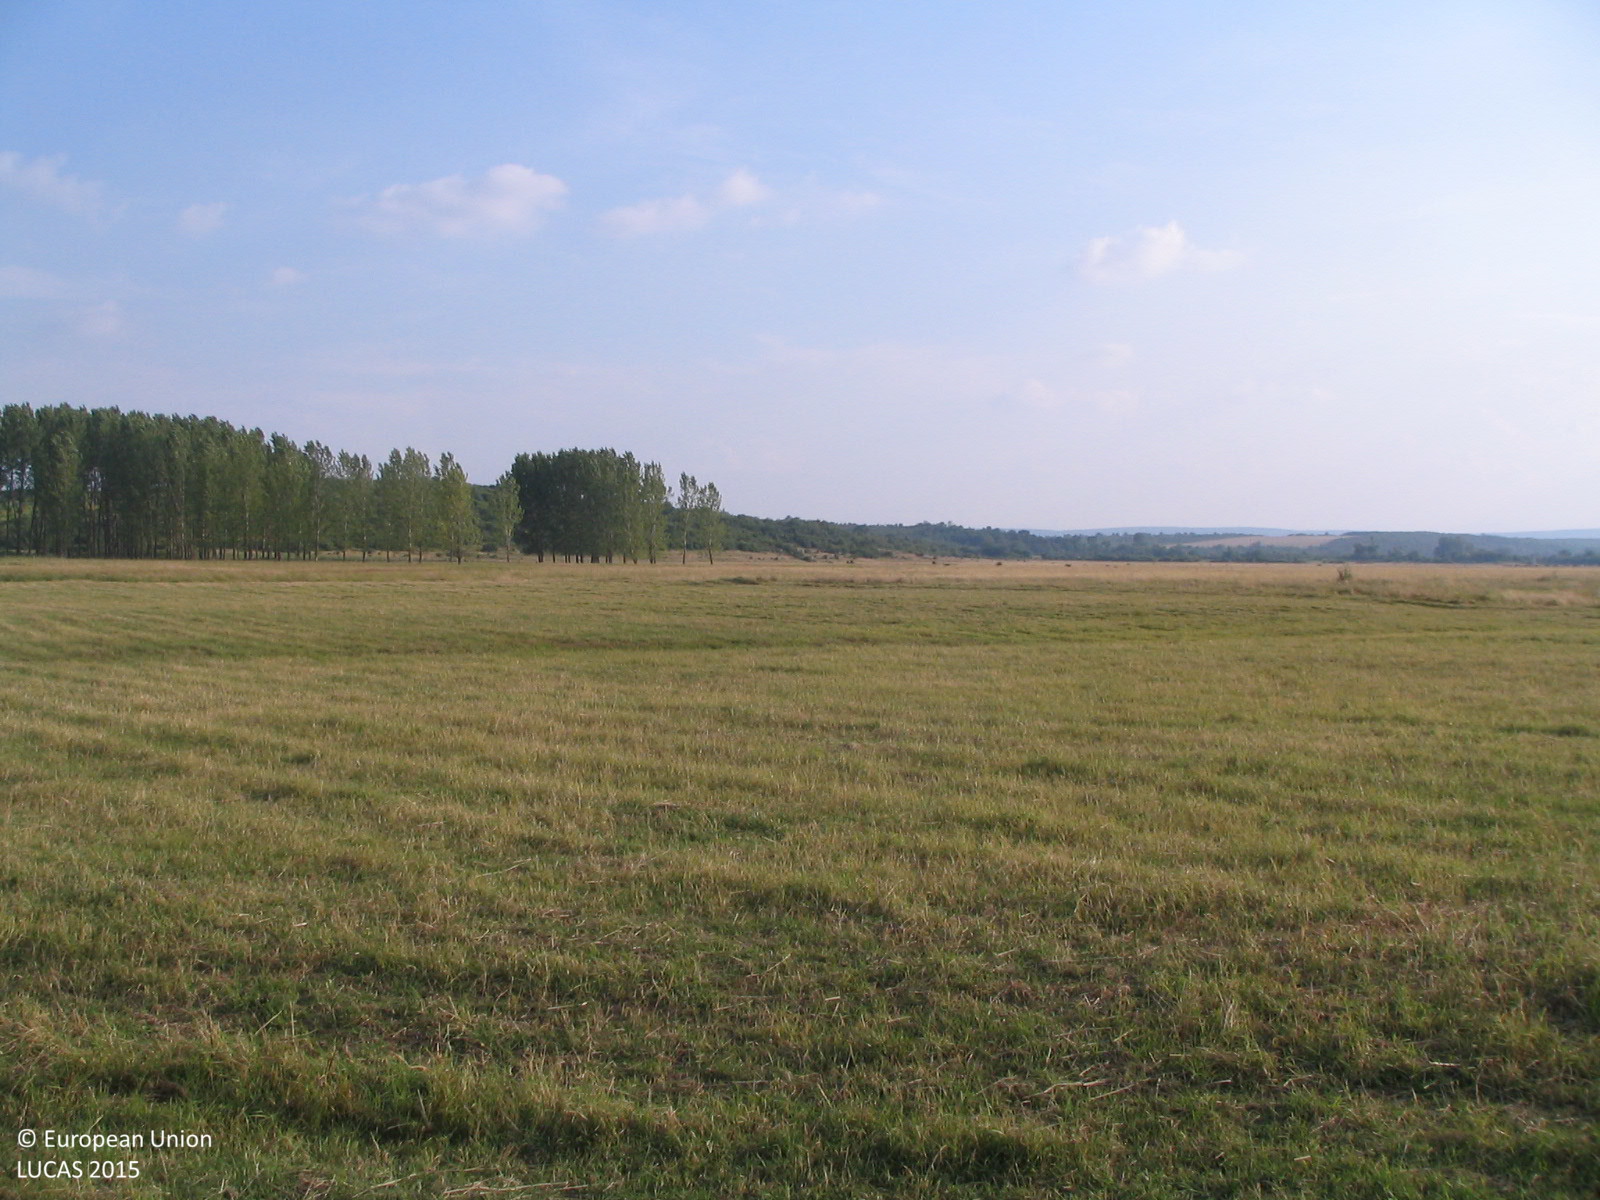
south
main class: Woodland
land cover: Broadleaved woodland
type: floodplain forest
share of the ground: > 75 %
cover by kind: broadleaved forest trees 90 %, shrubs 5 %, herbaceous plants 5 %
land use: Semi-natural and natural areas not in use
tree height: > 5 m
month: June
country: BG
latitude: 43.4040
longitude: 23.9423
